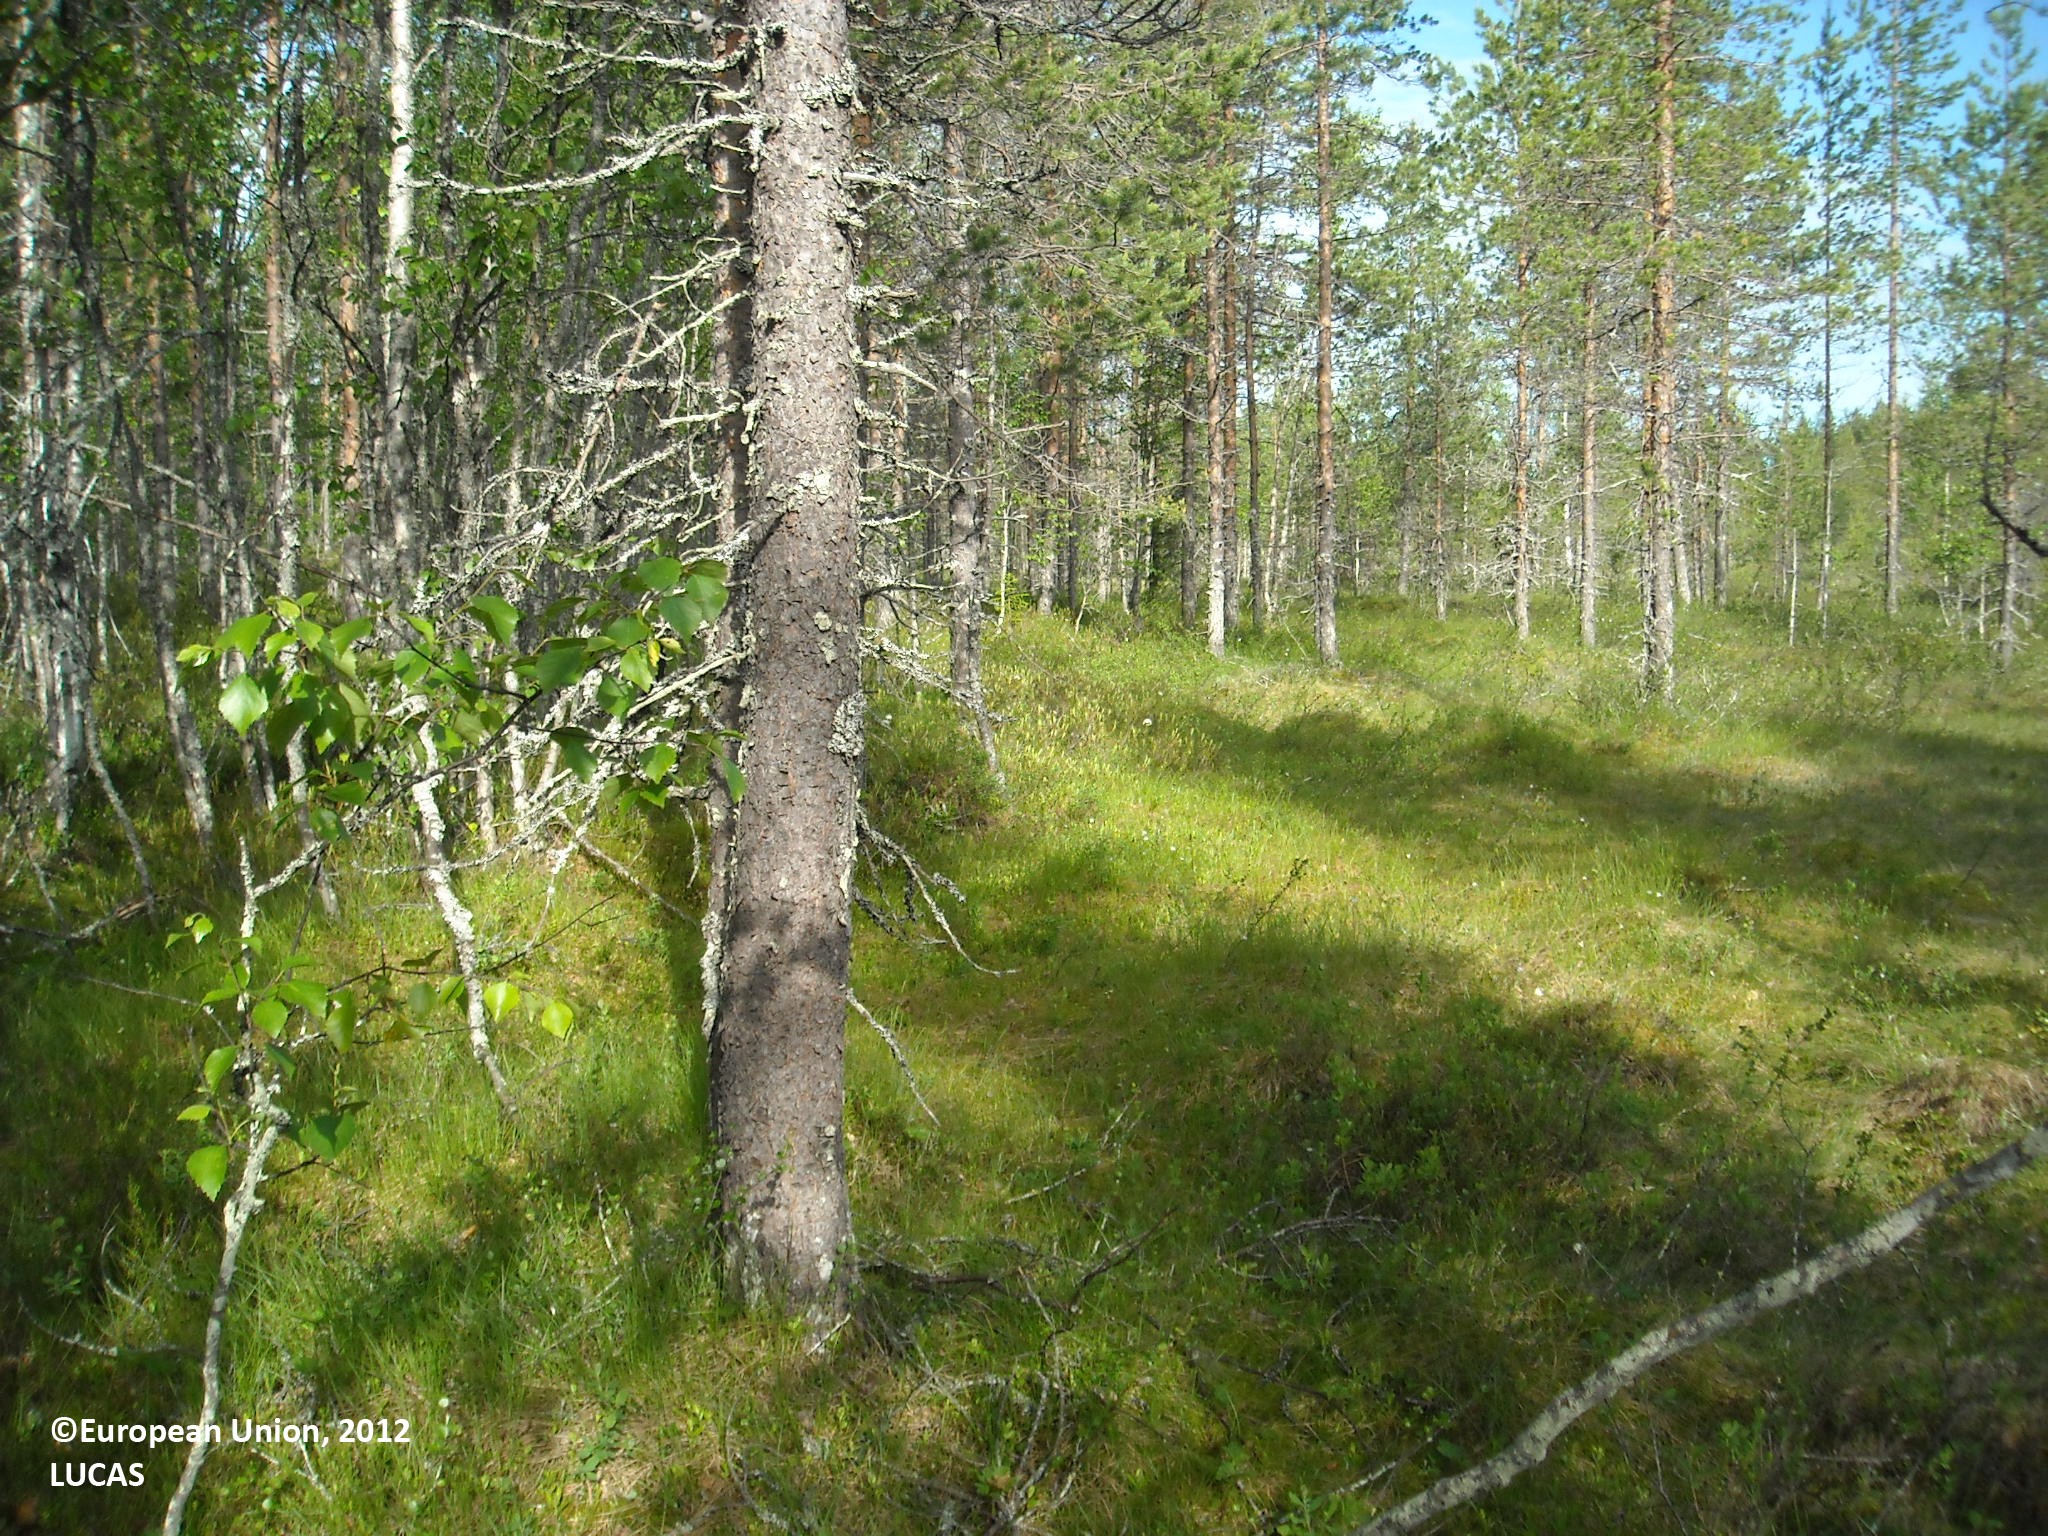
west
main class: Woodland
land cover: Pine dominated coniferous woodland
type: mire and swamp forests
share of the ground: > 75 %
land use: Forestry
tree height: > 5 m
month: July
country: FI
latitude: 64.6505
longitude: 27.7542
